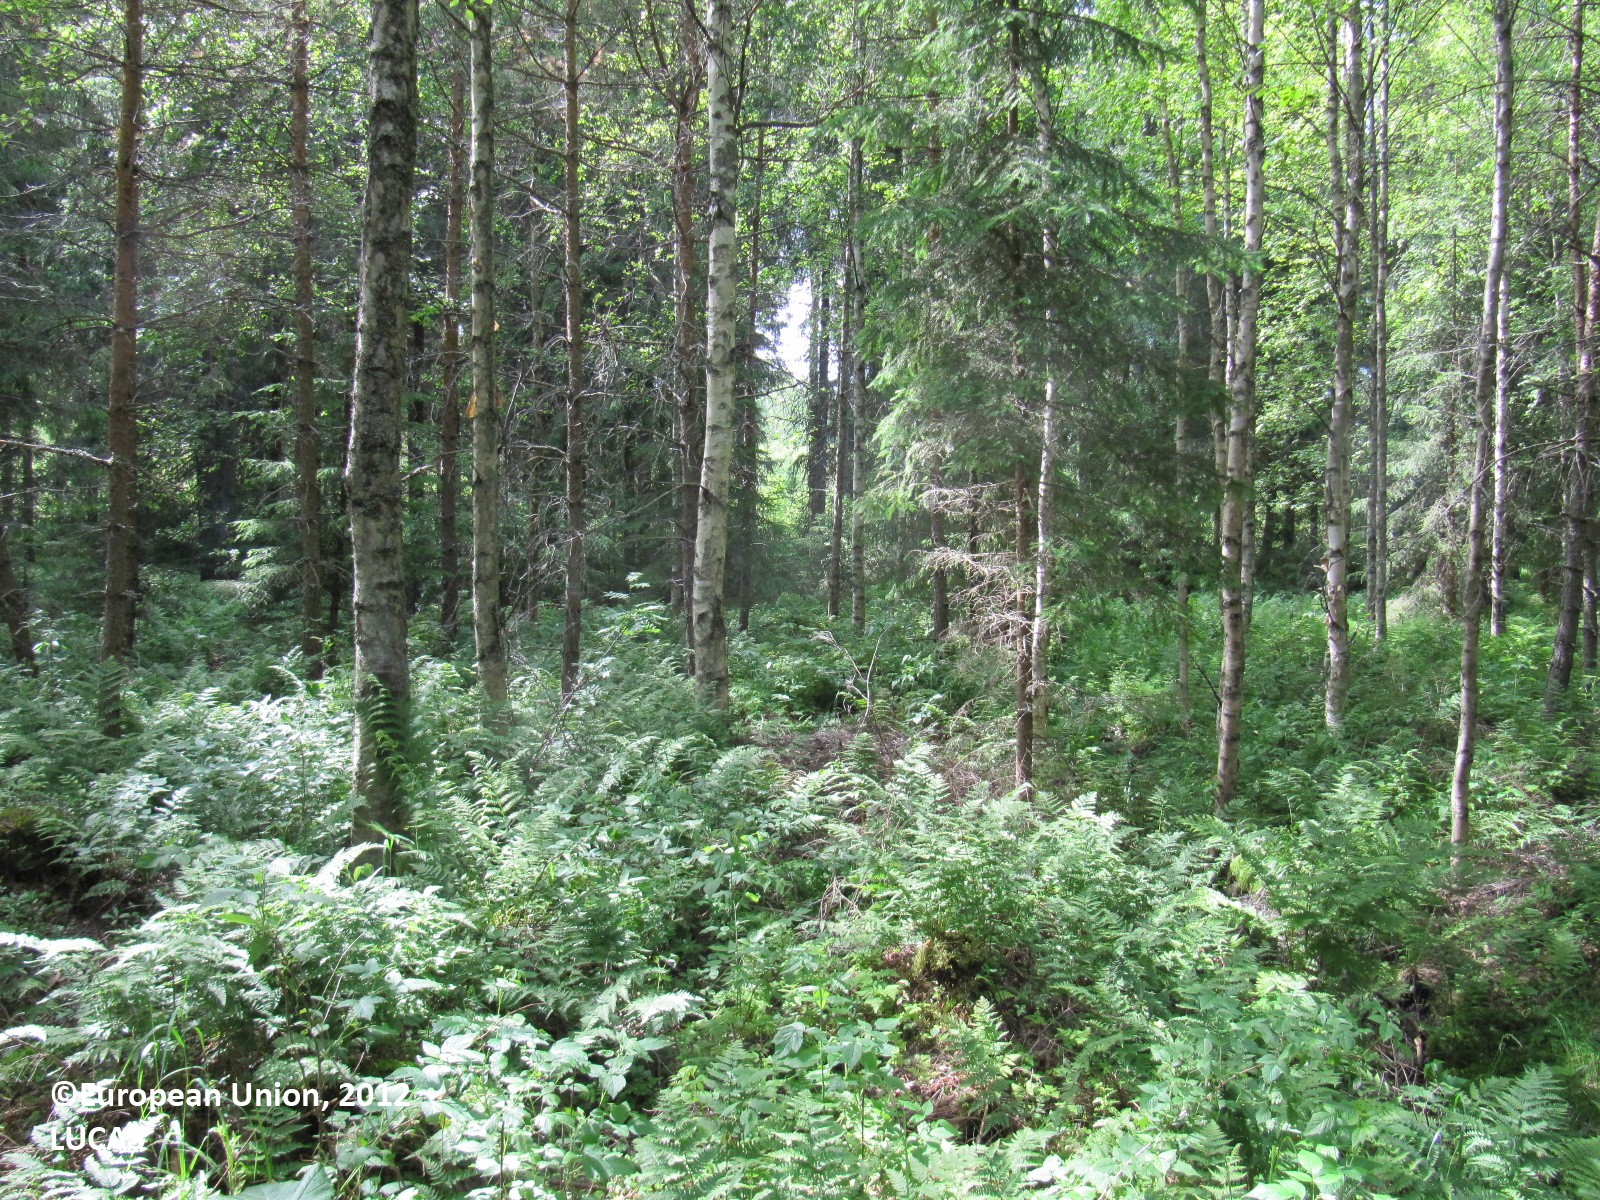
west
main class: Woodland
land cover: Spruce dominated mixed woodland
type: boreal forest
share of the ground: > 75 %
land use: Forestry
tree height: > 5 m
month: July
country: FI
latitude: 60.8806
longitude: 23.3262
